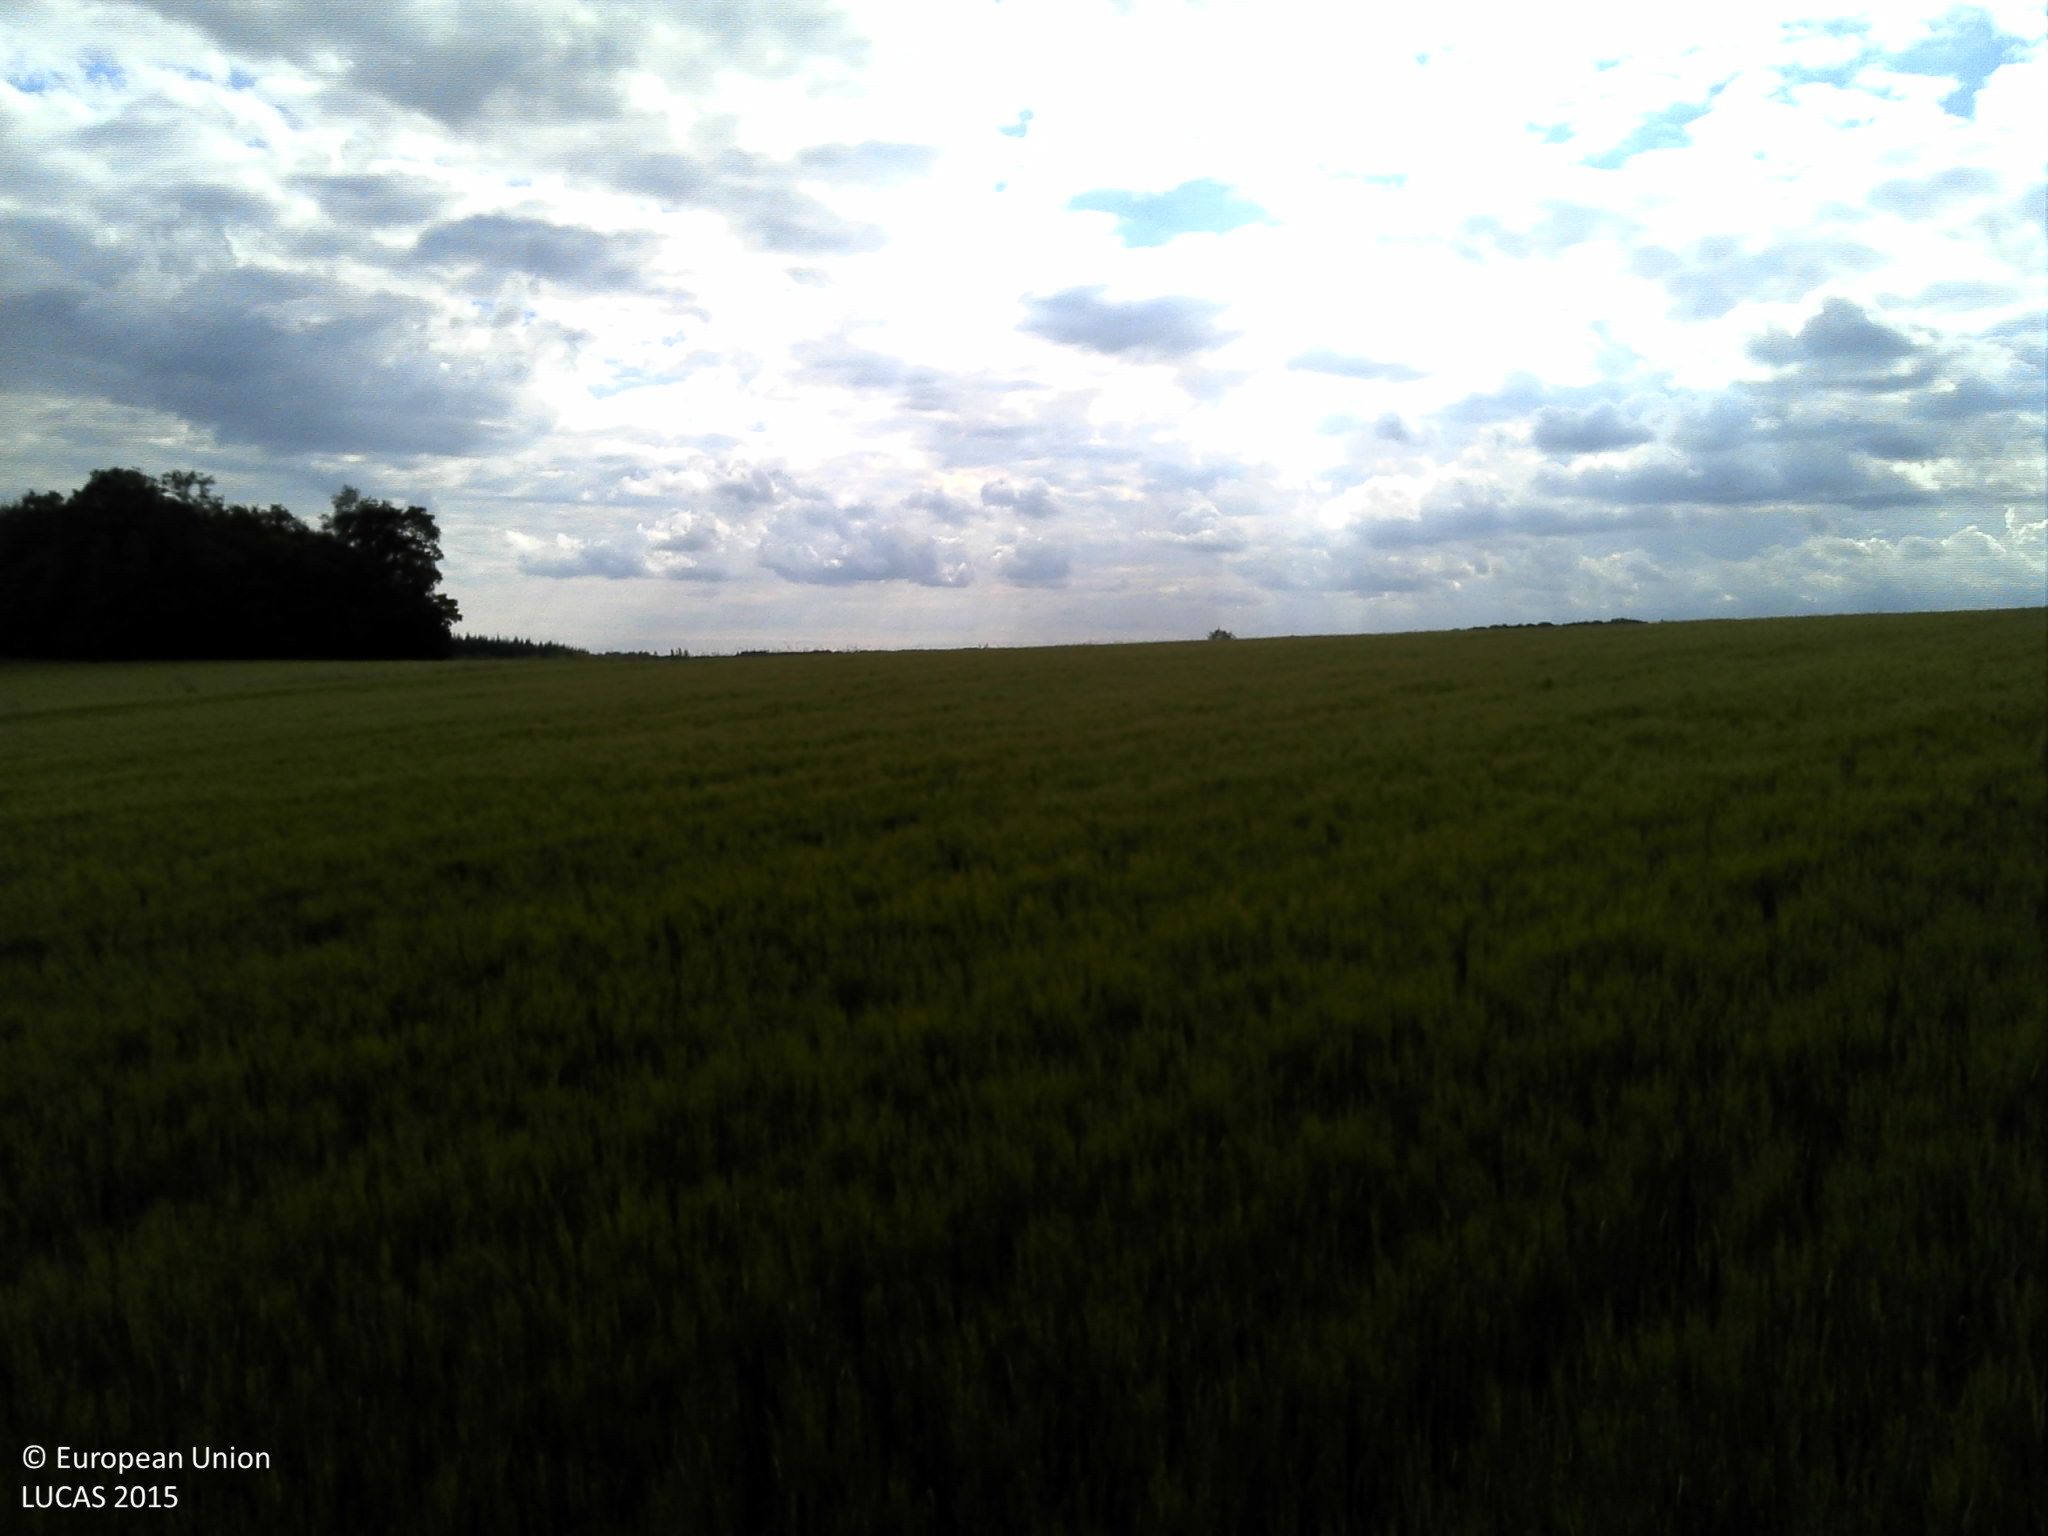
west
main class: Cropland
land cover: Barley
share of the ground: > 75 %
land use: Agriculture (excluding fallow land and kitchen gardens)
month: June
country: FR
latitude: 49.6513
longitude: 4.8029
